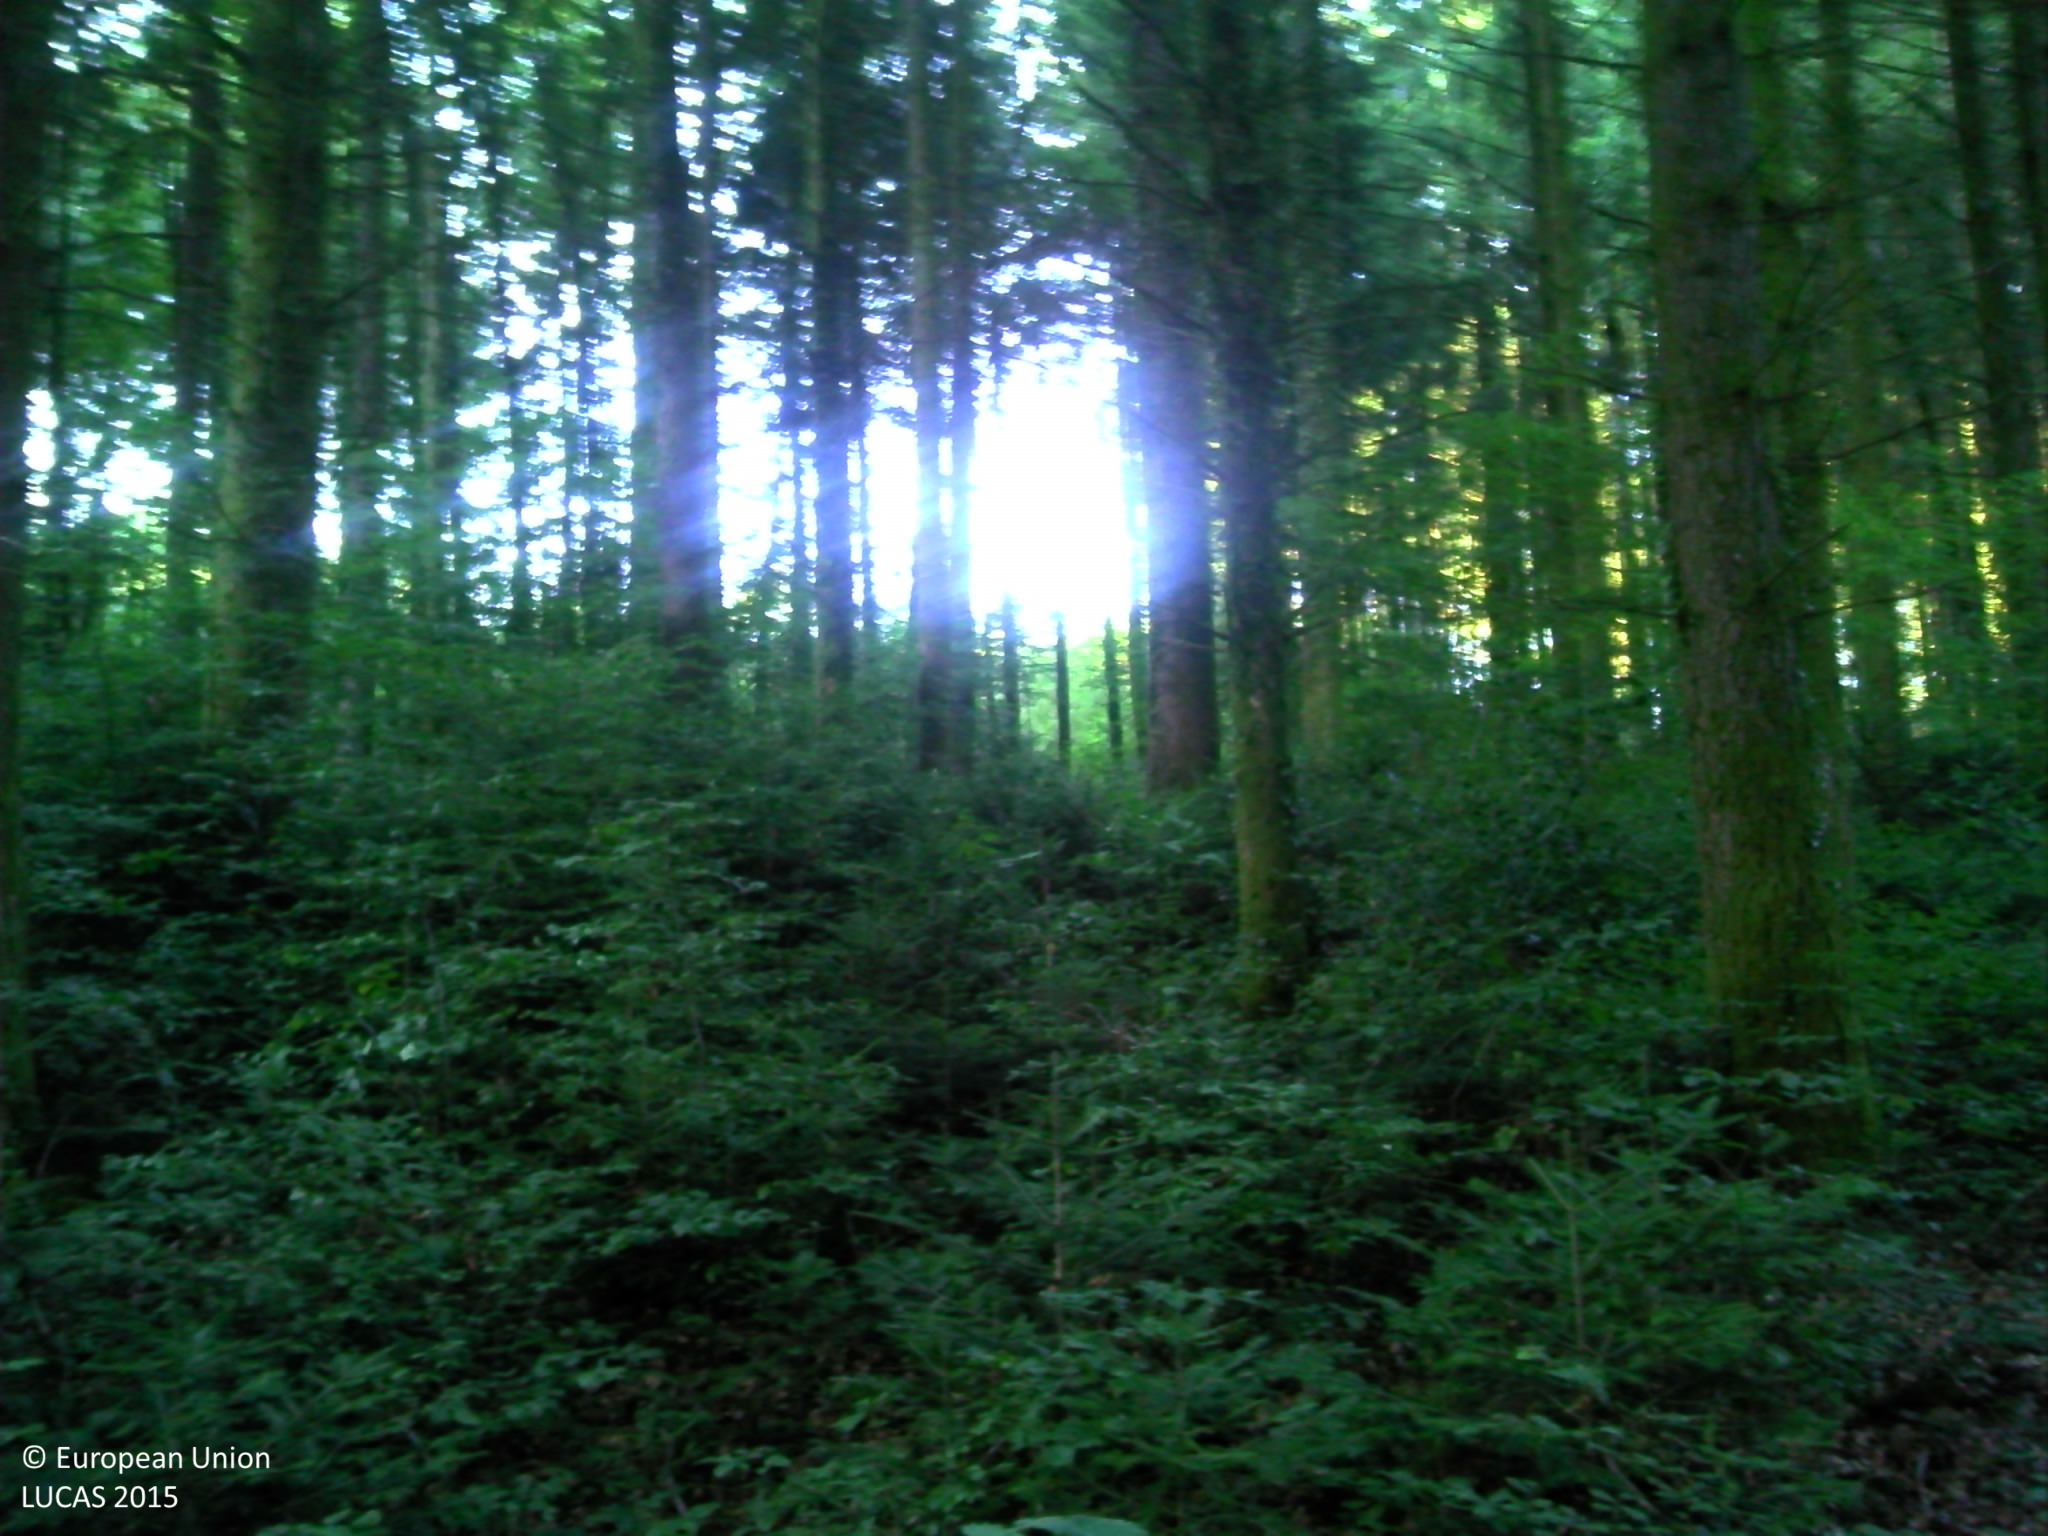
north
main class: Woodland
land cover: Other mixed woodland
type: exotic forest
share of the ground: > 75 %
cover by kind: coniferous forest trees 60 %, broadleaved forest trees 25 %, shrubs 5 %, herbaceous plants 5 %, lichens and mosses 5 %
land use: Forestry
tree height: > 5 m
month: August
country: FR
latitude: 45.8900
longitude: 1.7847
